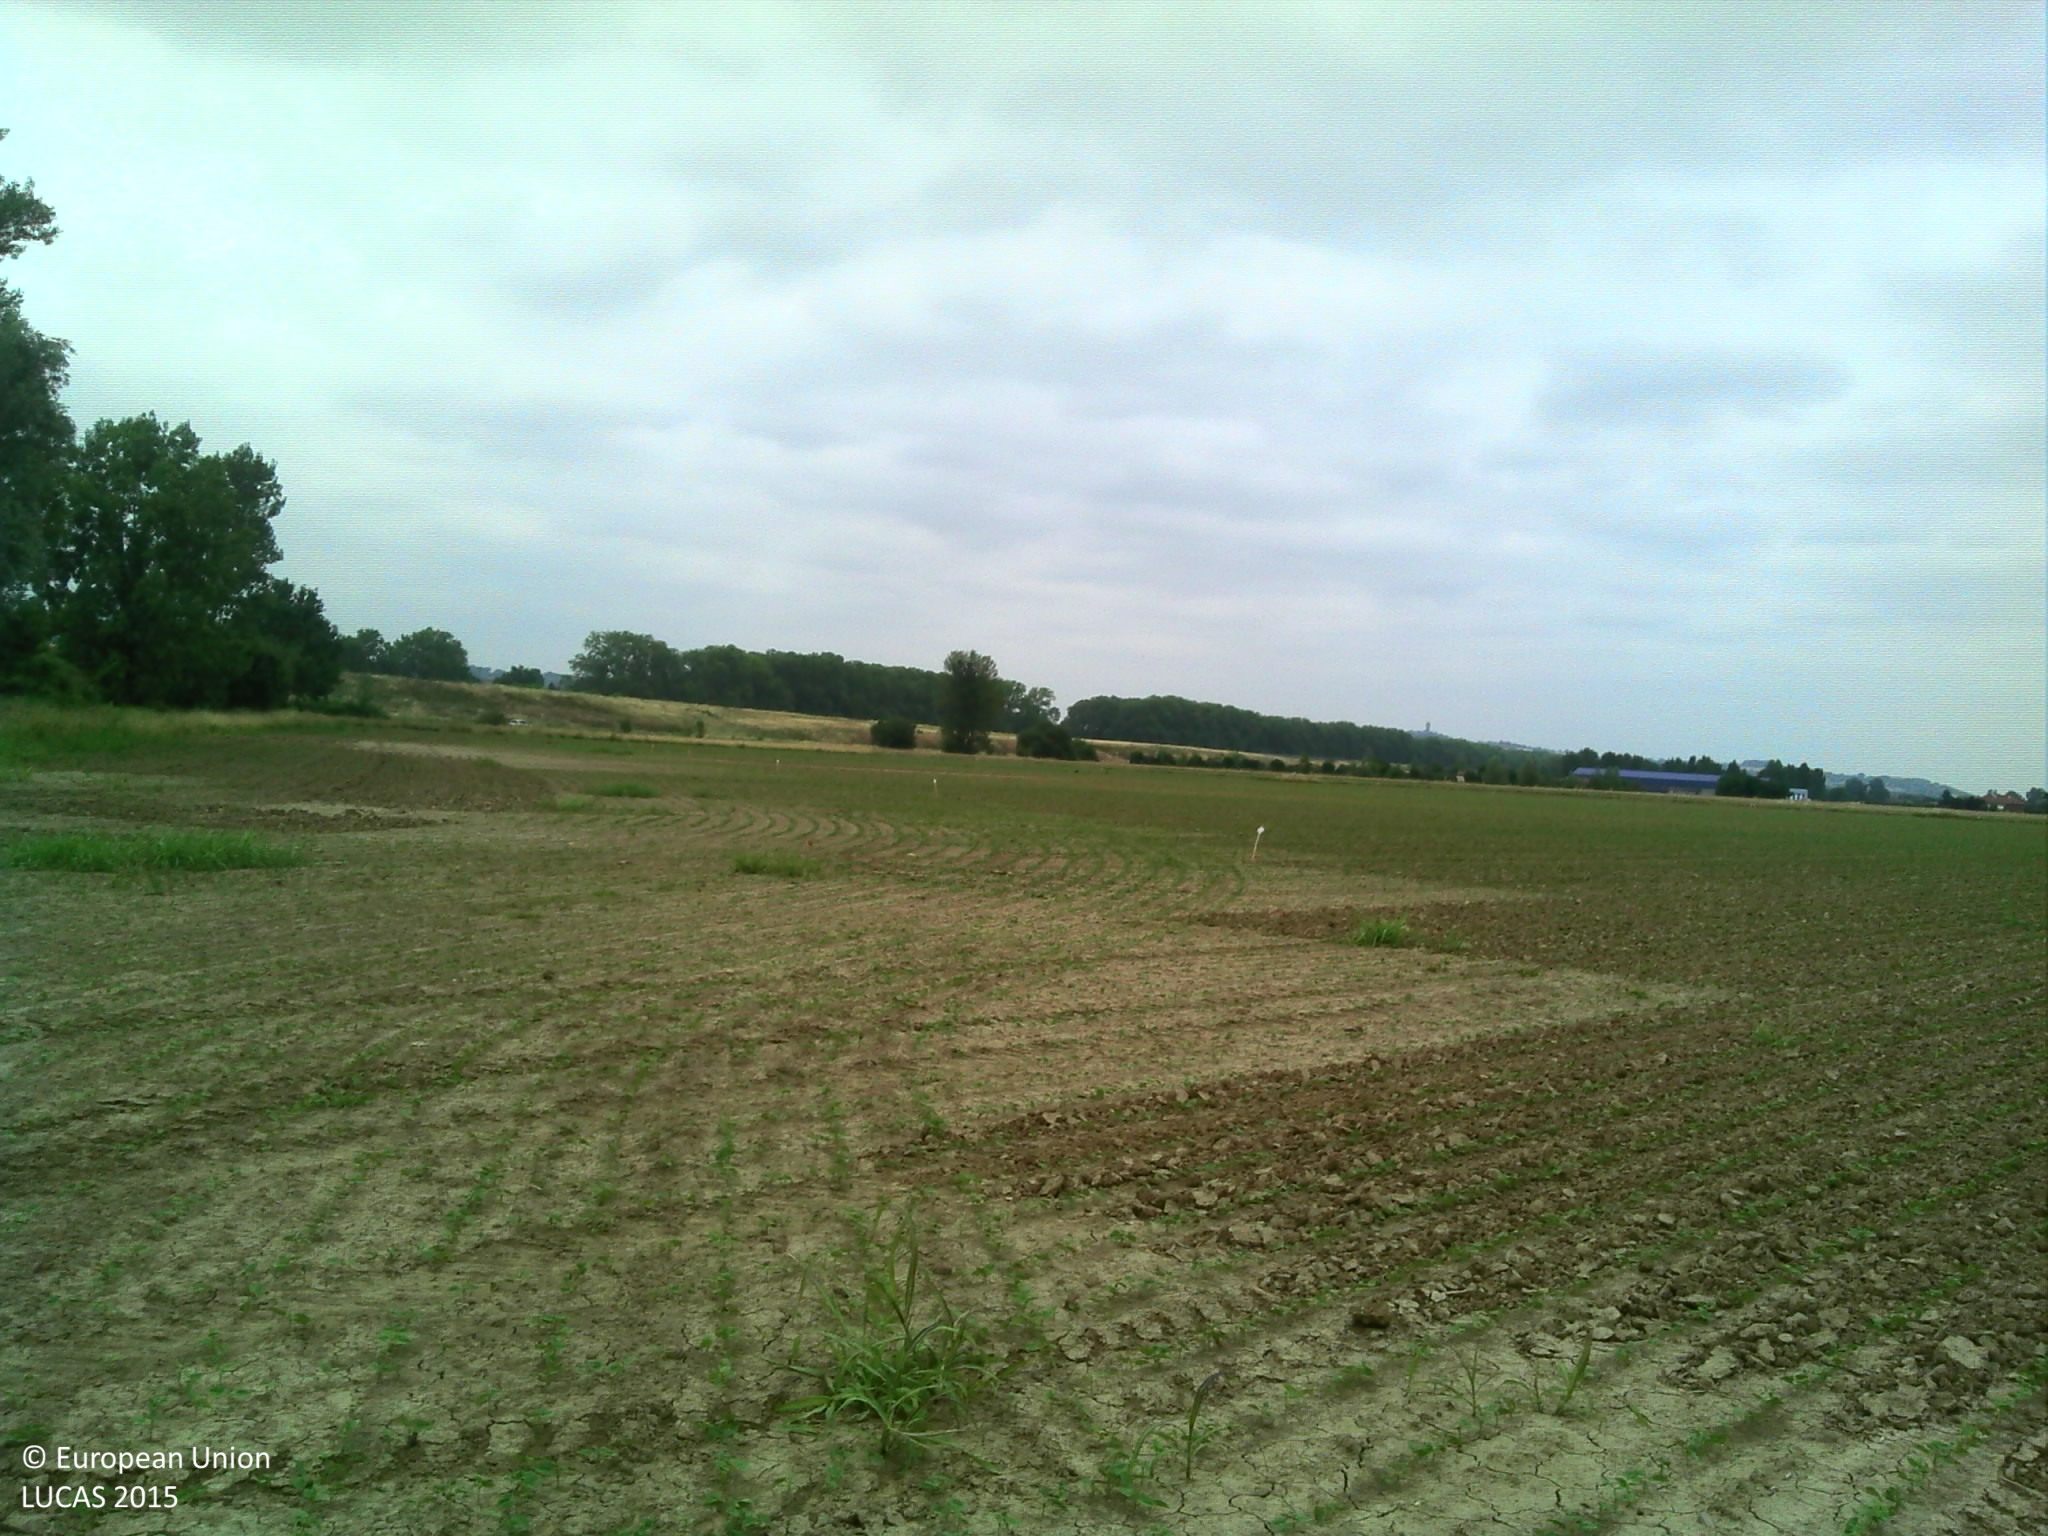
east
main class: Cropland
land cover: Other fresh vegetables
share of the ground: < 10 %
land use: Agriculture (excluding fallow land and kitchen gardens)
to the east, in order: Other fresh vegetables
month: June
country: FR
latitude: 44.0966
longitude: 0.9160
